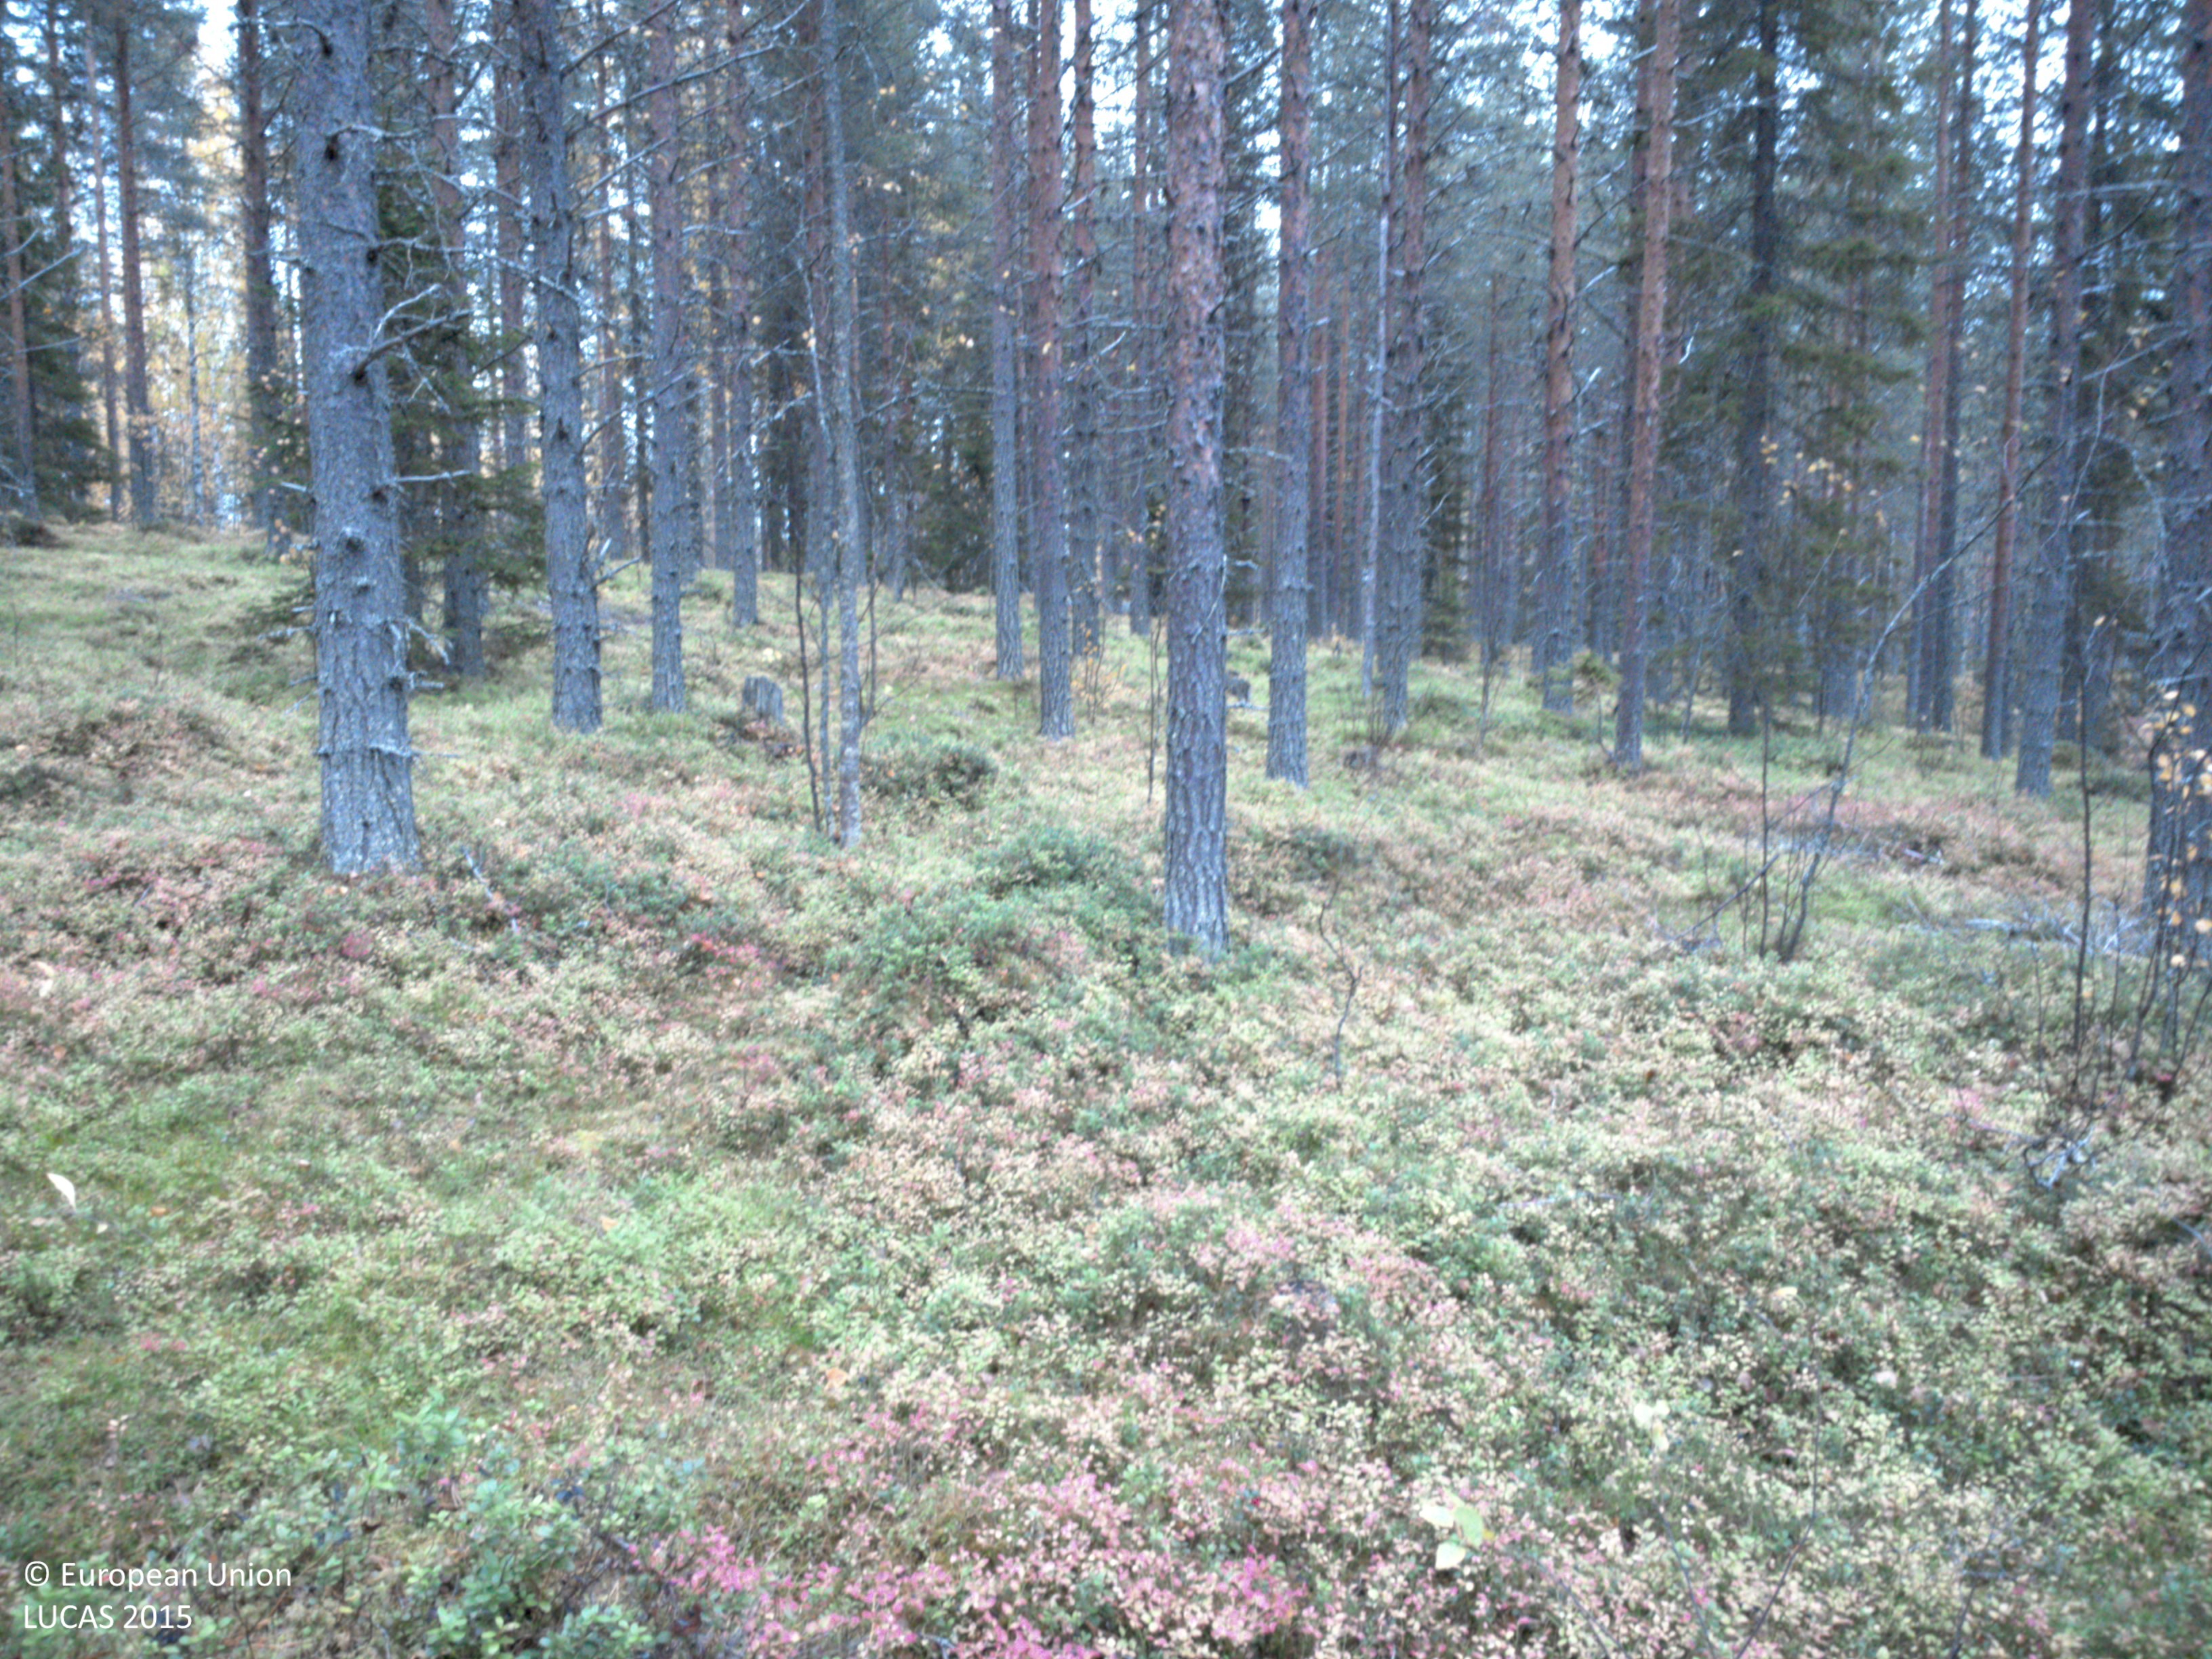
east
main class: Woodland
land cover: Pine dominated coniferous woodland
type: boreal forest
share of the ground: > 75 %
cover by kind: coniferous forest trees 80 %, shrubs 15 %, lichens and mosses 5 %
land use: Forestry
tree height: > 5 m
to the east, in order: Pine dominated coniferous woodland
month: October
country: SE
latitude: 64.9778
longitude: 17.9945
